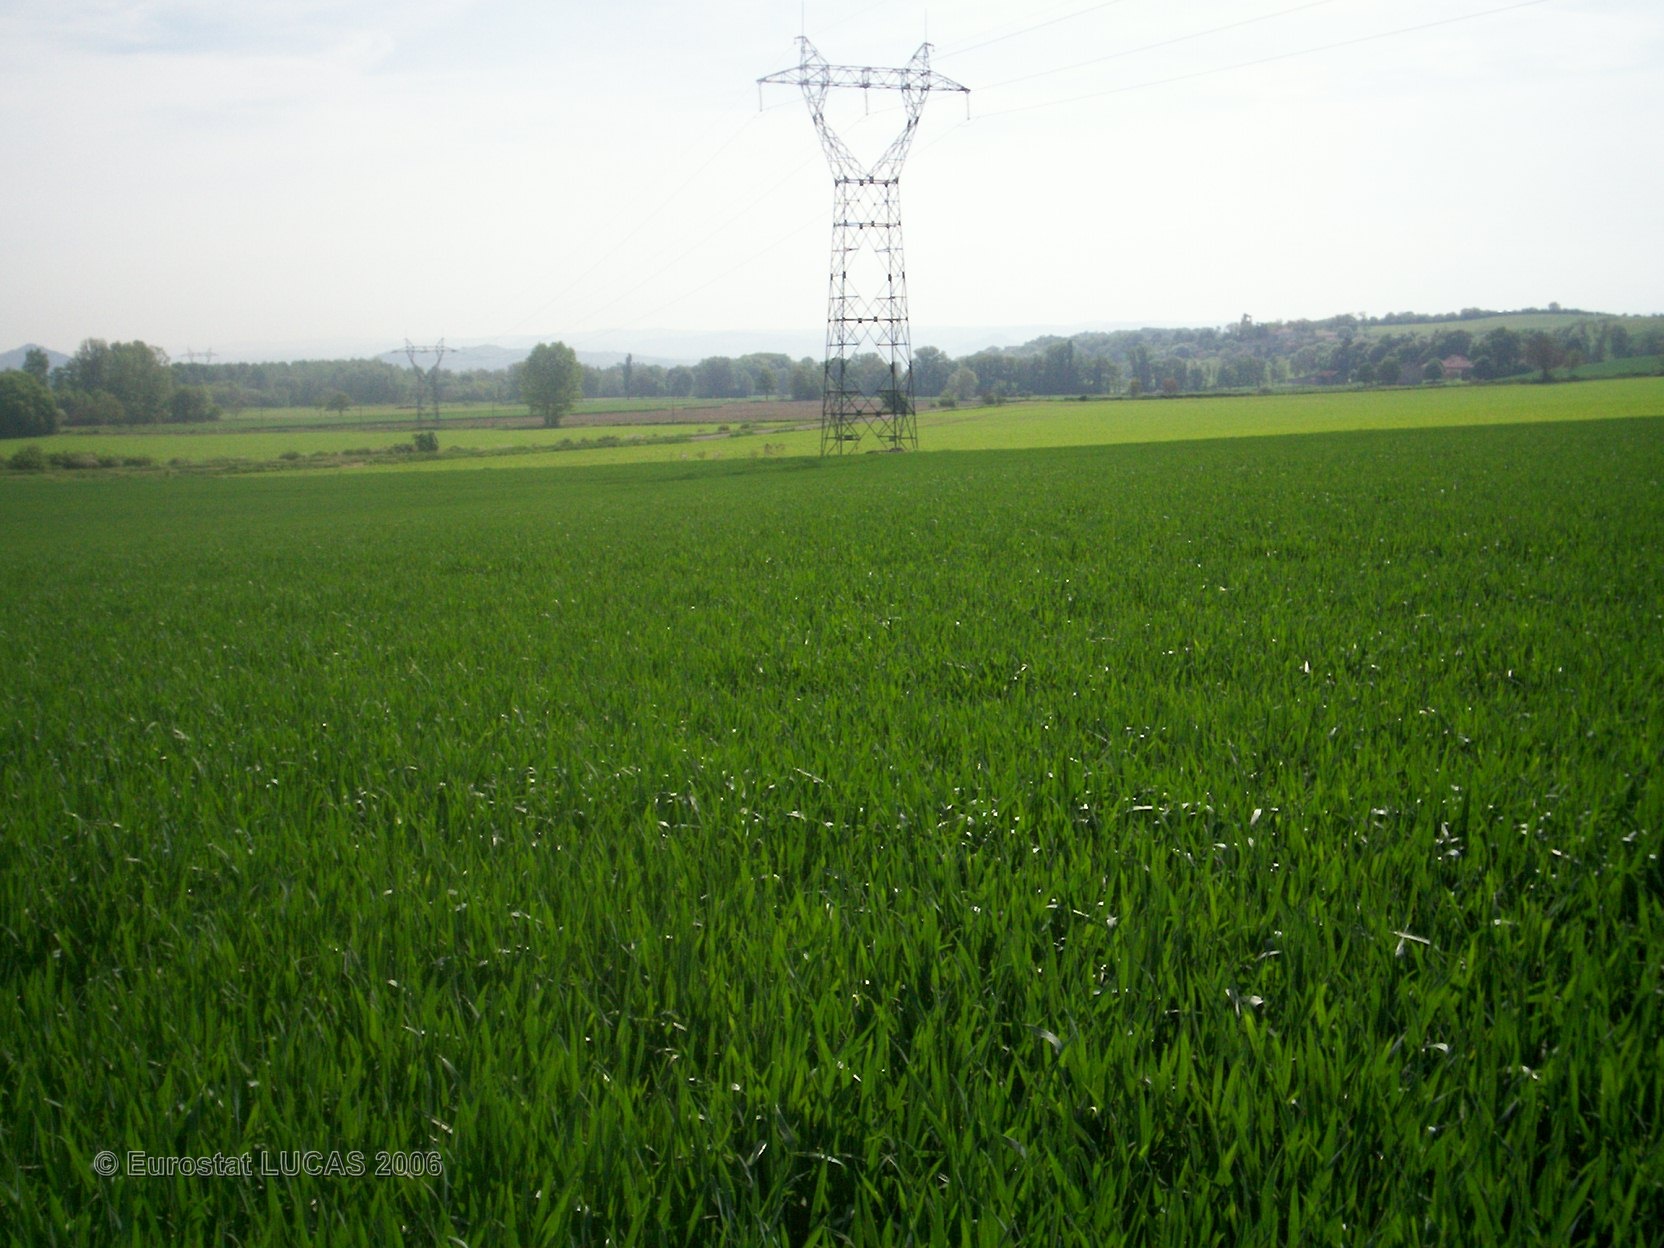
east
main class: Cropland
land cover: Common wheat
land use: Agriculture (excluding fallow land and kitchen gardens)
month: May
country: FR
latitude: 45.5382
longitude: 3.2007
